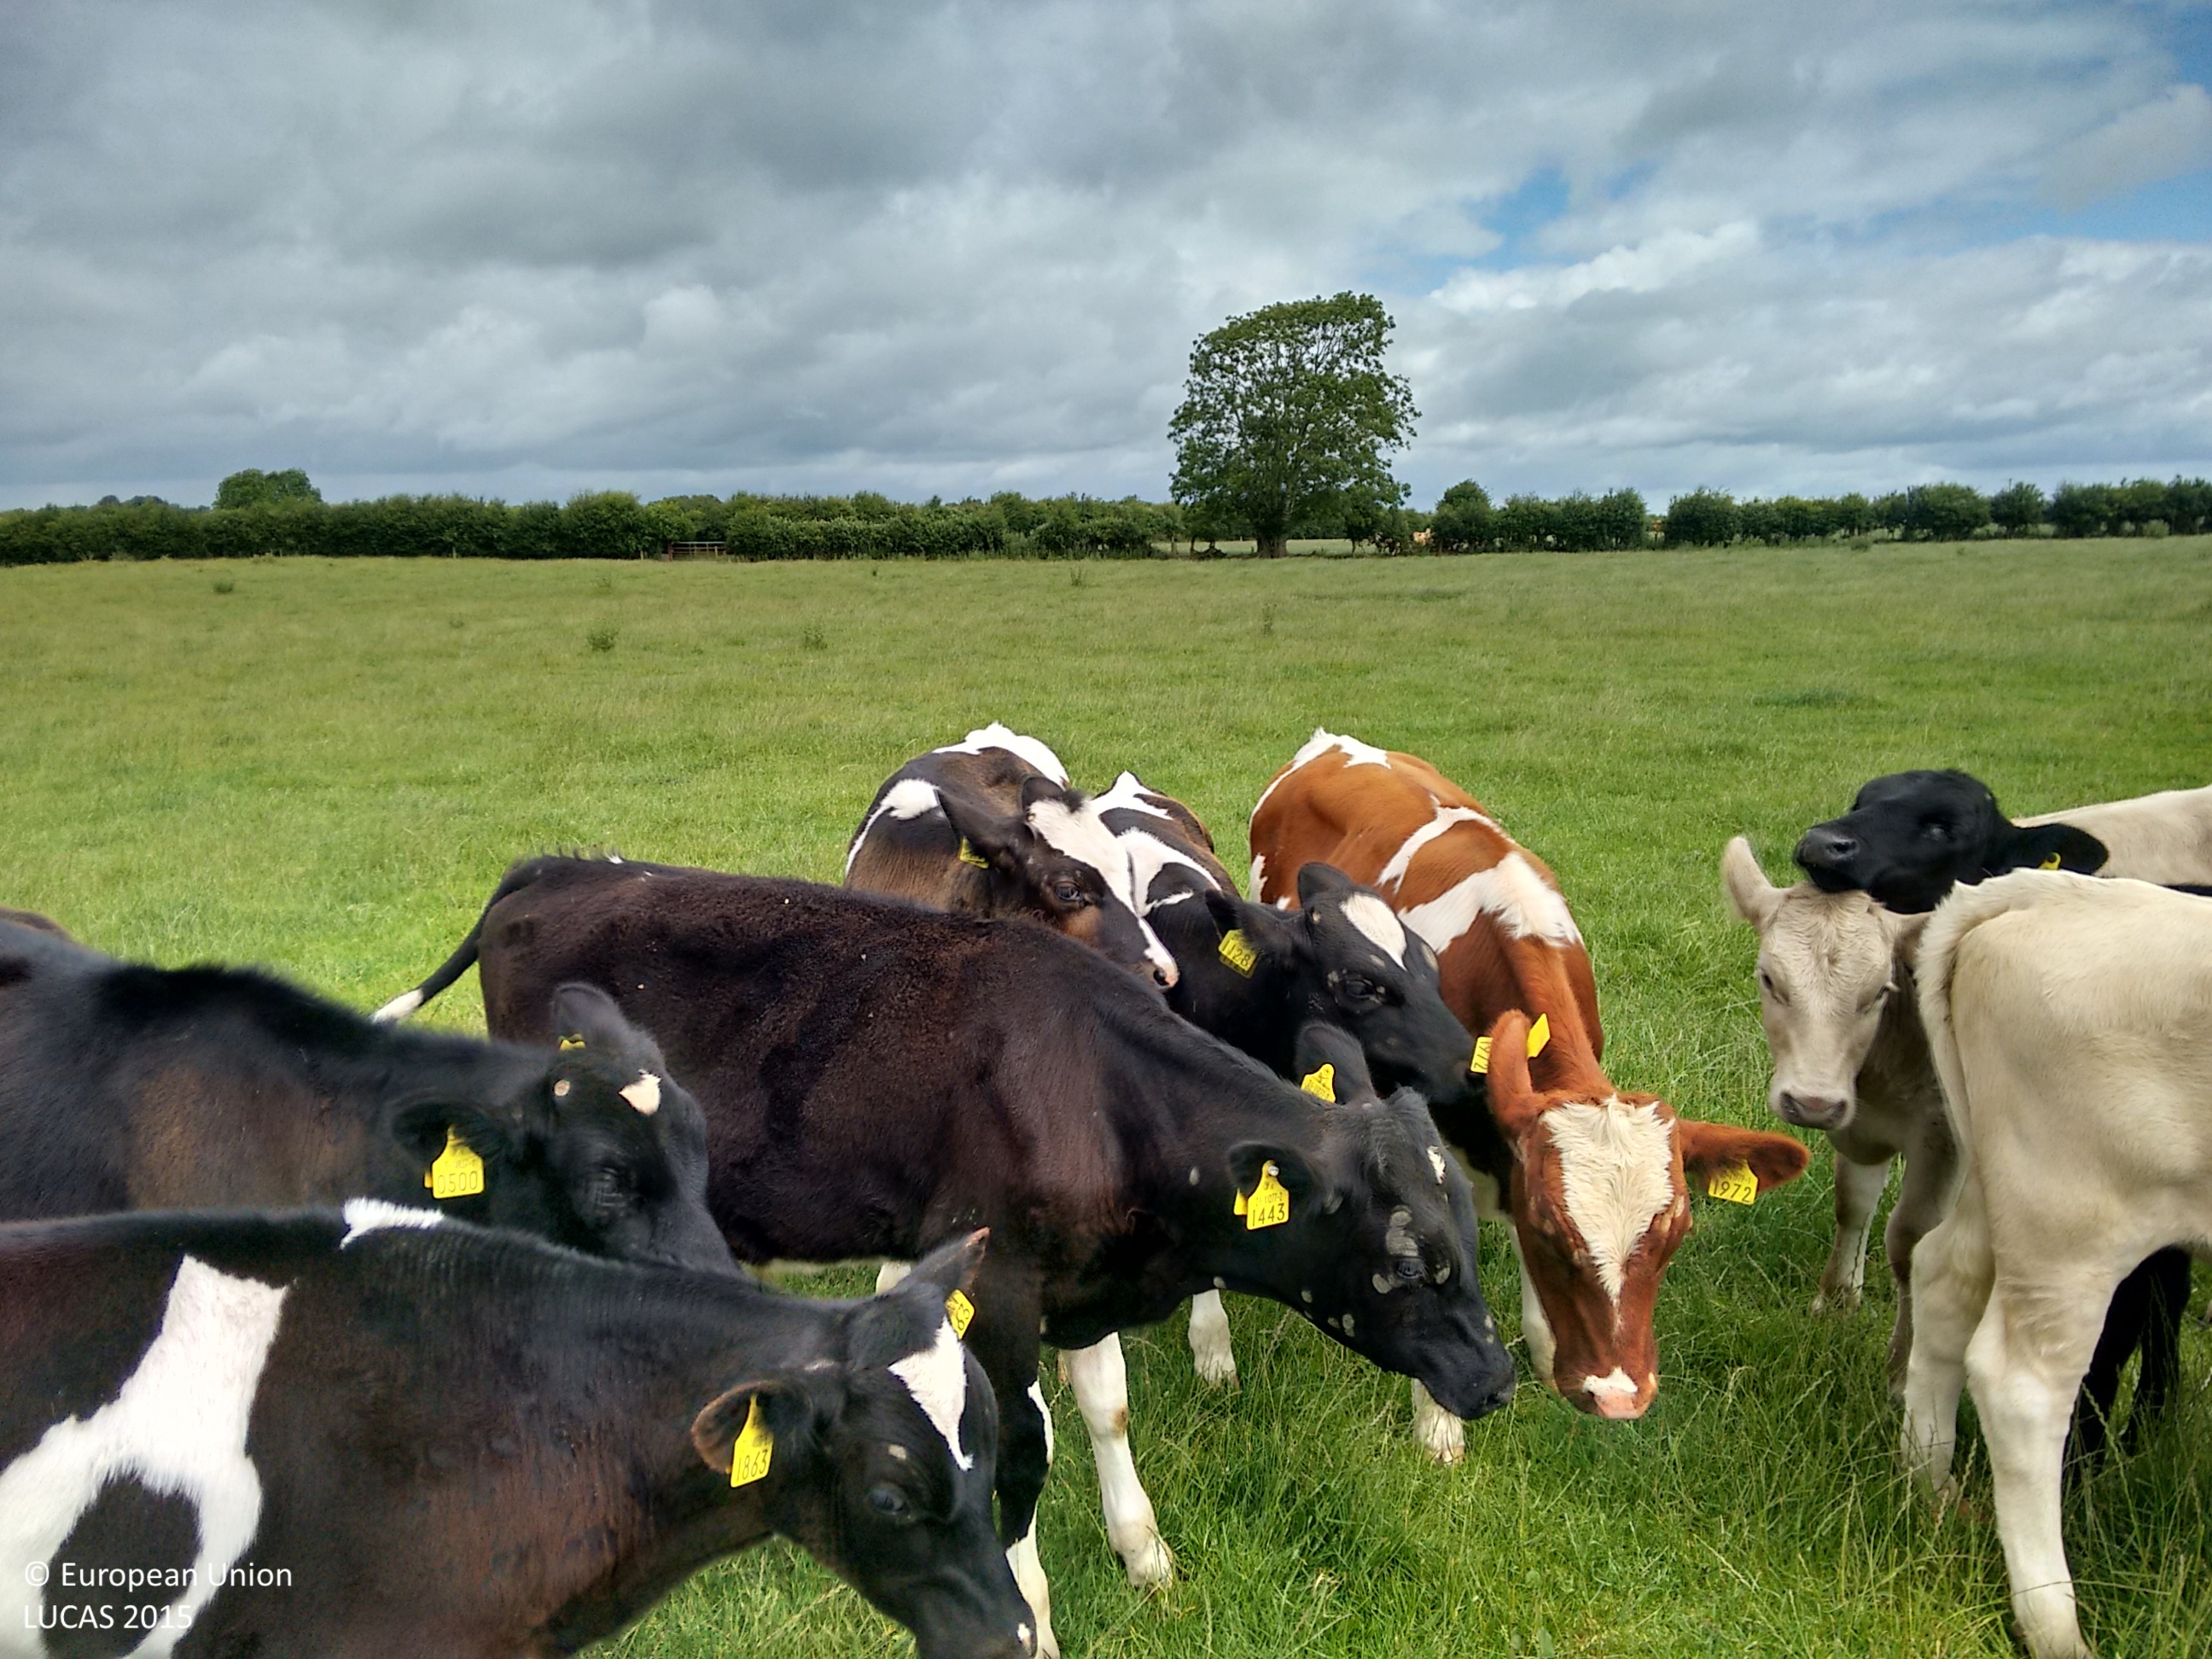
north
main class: Grassland
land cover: Grassland without tree/shrub cover
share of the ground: > 75 %
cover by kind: herbaceous plants 100 %
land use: Agriculture (excluding fallow land and kitchen gardens)
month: July
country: IE
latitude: 52.8038
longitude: -7.5604
